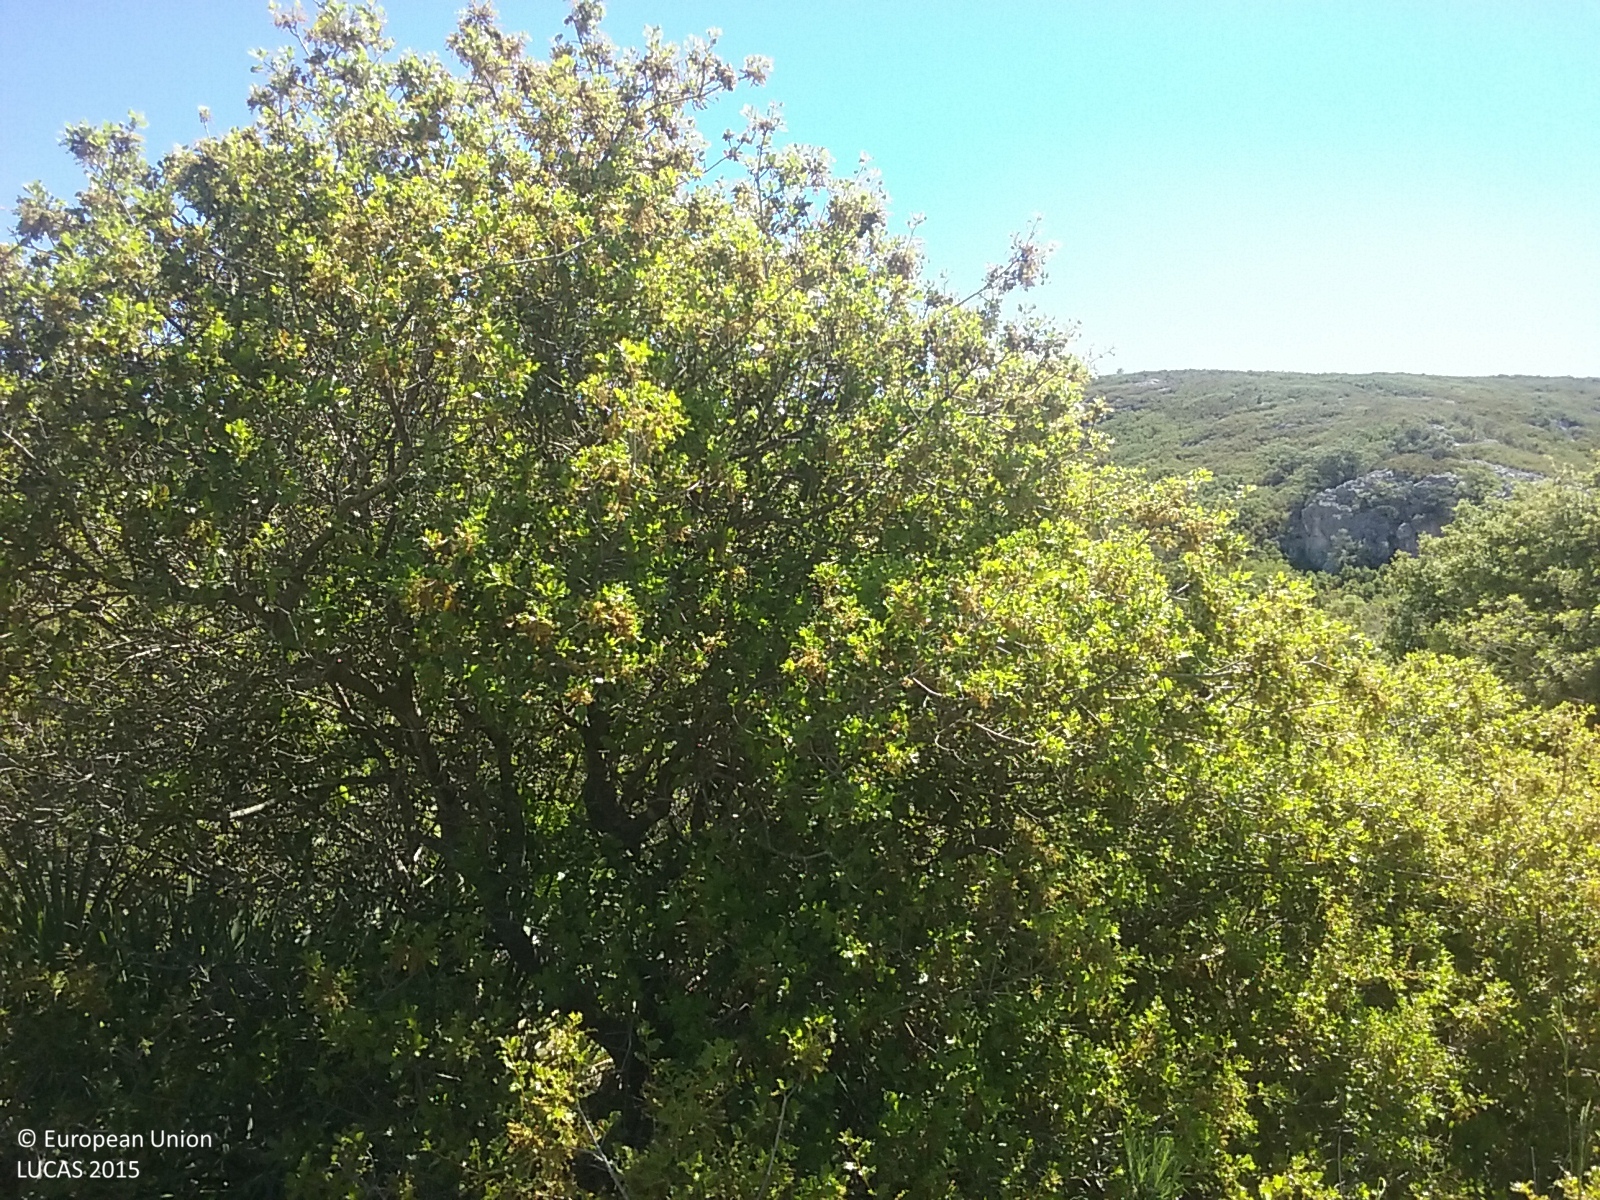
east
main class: Shrubland
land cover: Shrubland with sparse tree cover
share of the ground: > 75 %
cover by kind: shrubs 85 %, broadleaved forest trees 5 %
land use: Semi-natural and natural areas not in use
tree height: < 5 m
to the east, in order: Shrubland with sparse tree cover; Tracks; Shrubland without tree cover; Tracks; Shrubland without tree cover
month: May
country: ES
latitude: 40.4763
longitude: 0.2880
